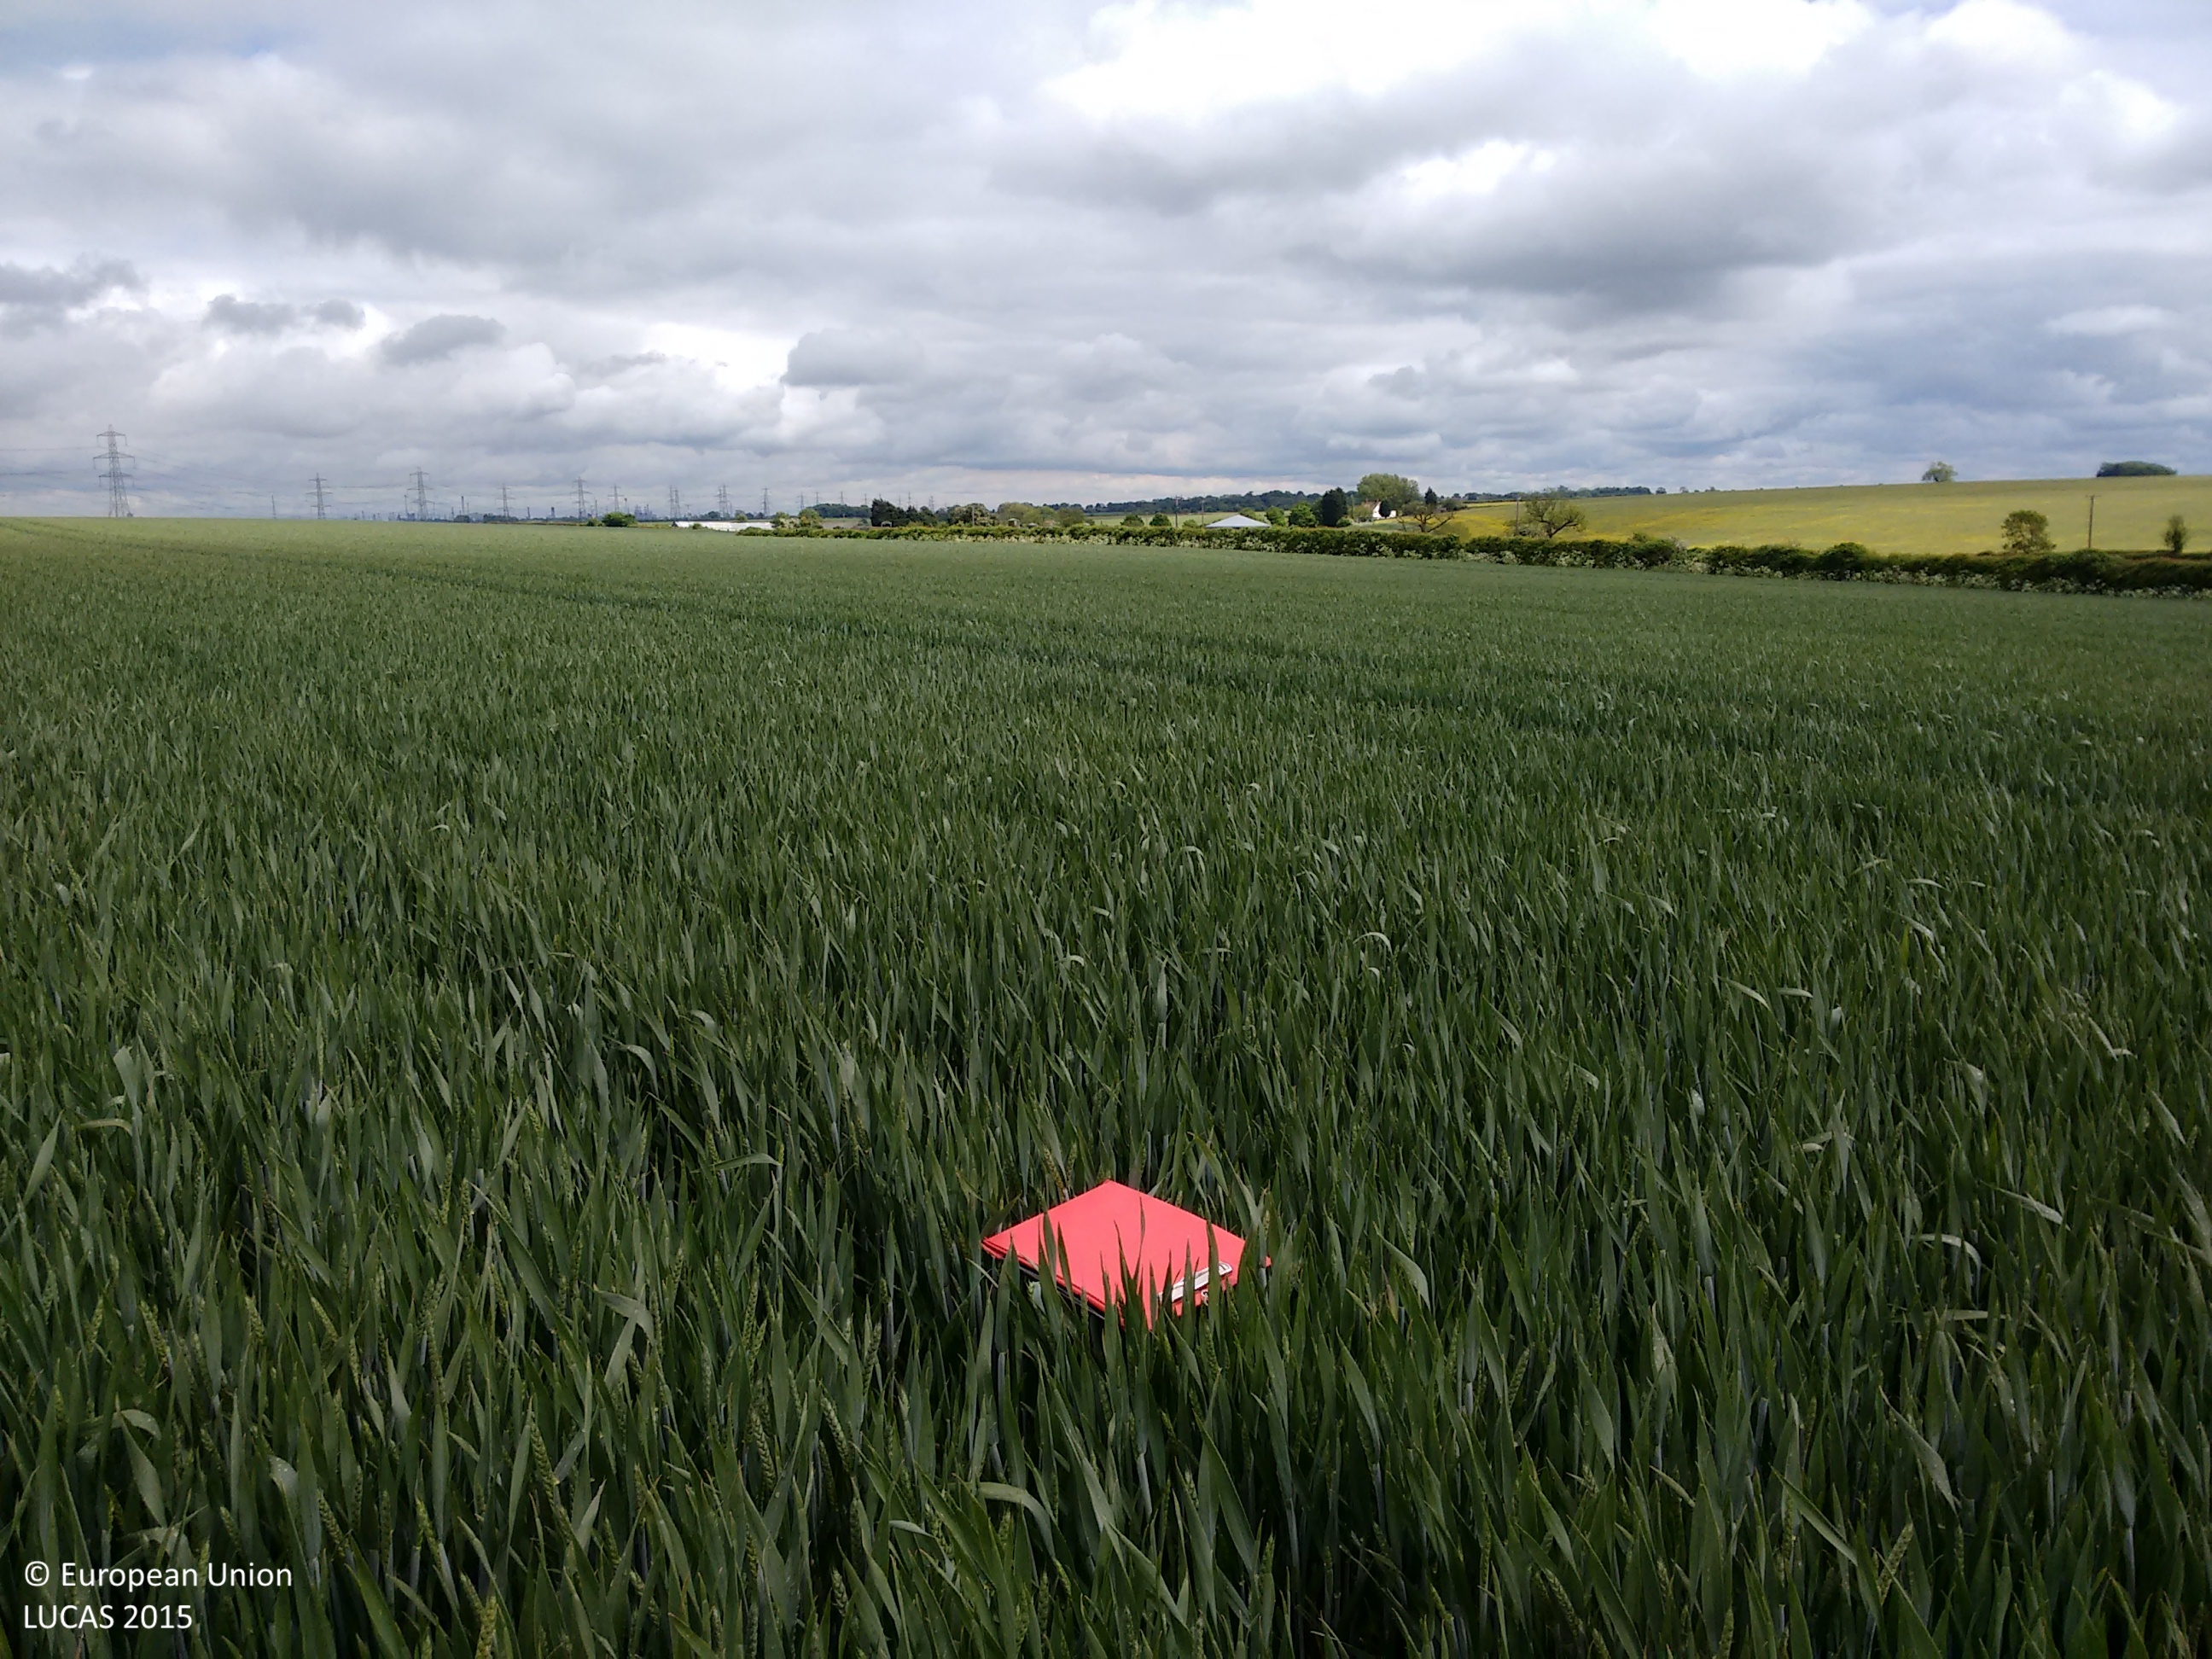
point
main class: Cropland
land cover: Common wheat
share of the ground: > 75 %
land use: Agriculture (excluding fallow land and kitchen gardens)
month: May
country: GB
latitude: 53.6422
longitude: -0.3973
